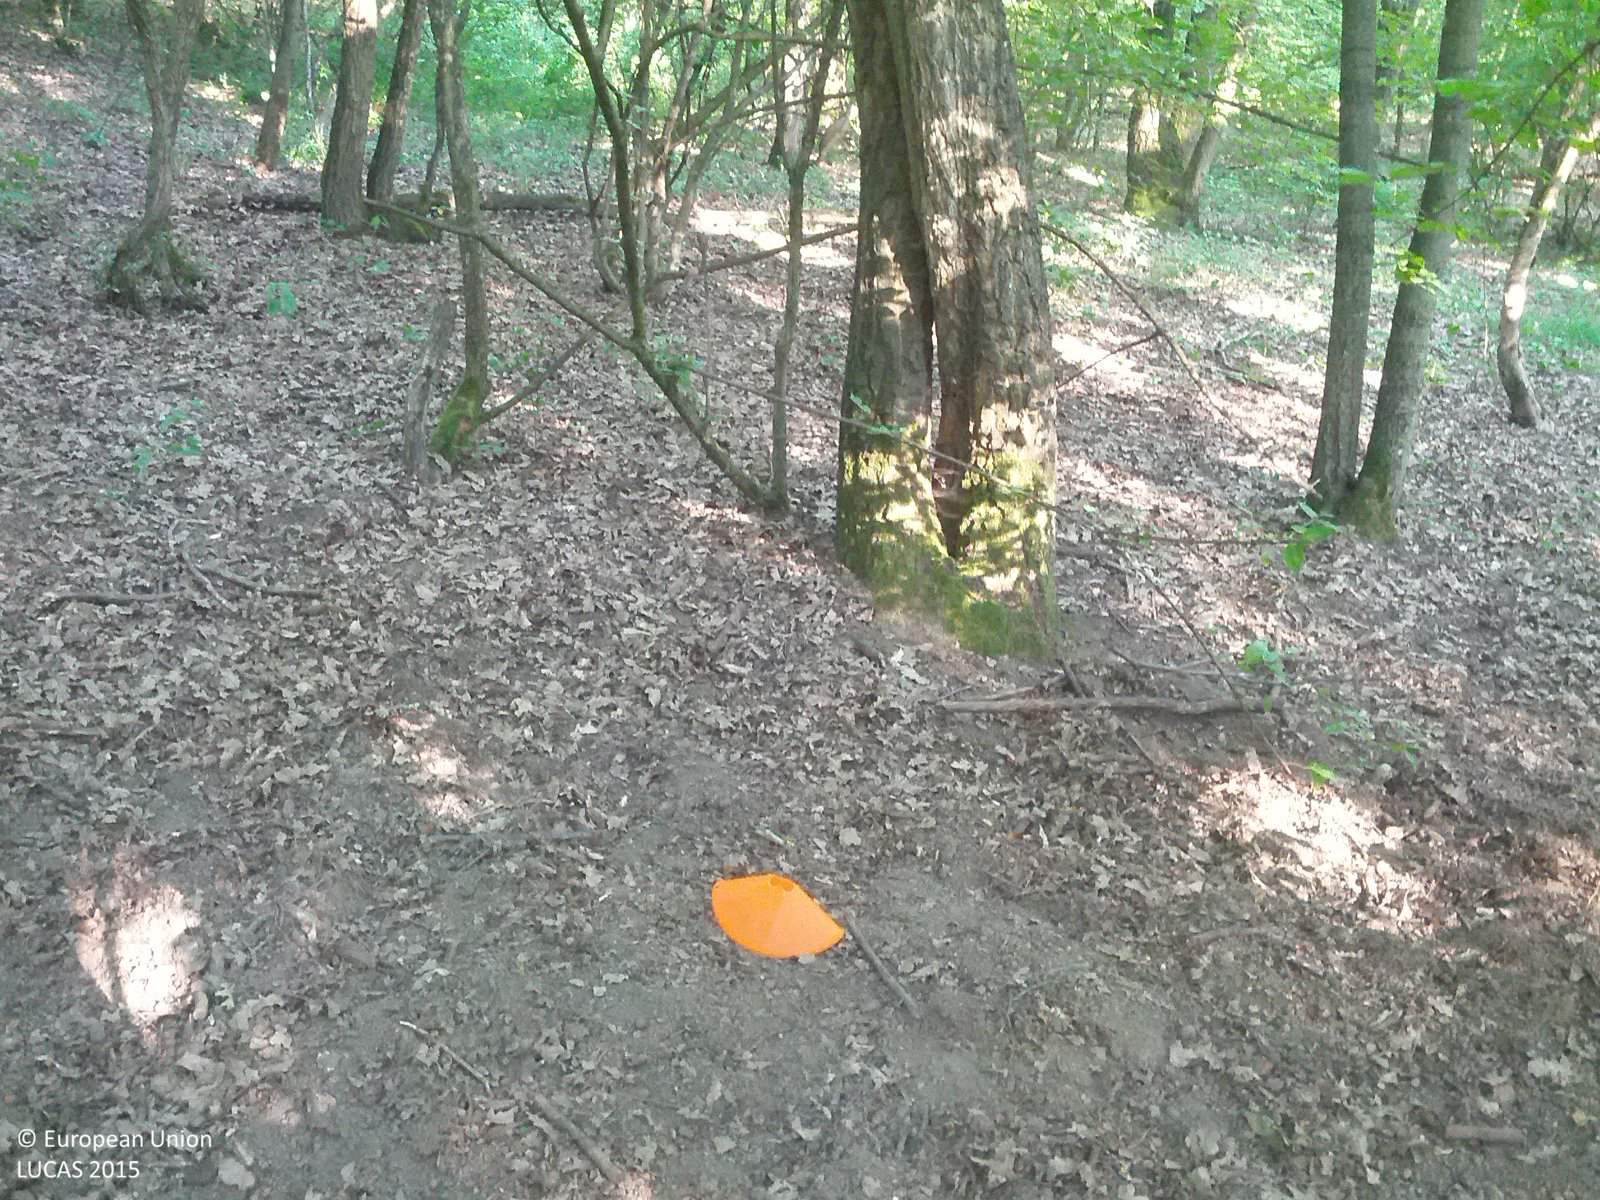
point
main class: Woodland
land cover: Broadleaved woodland
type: mesophytic deciduous forest
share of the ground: > 75 %
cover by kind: broadleaved forest trees 90 %, unconsolidated bare surface 10 %
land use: Forestry
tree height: > 5 m
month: July
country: AT
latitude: 48.3894
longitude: 16.5557
